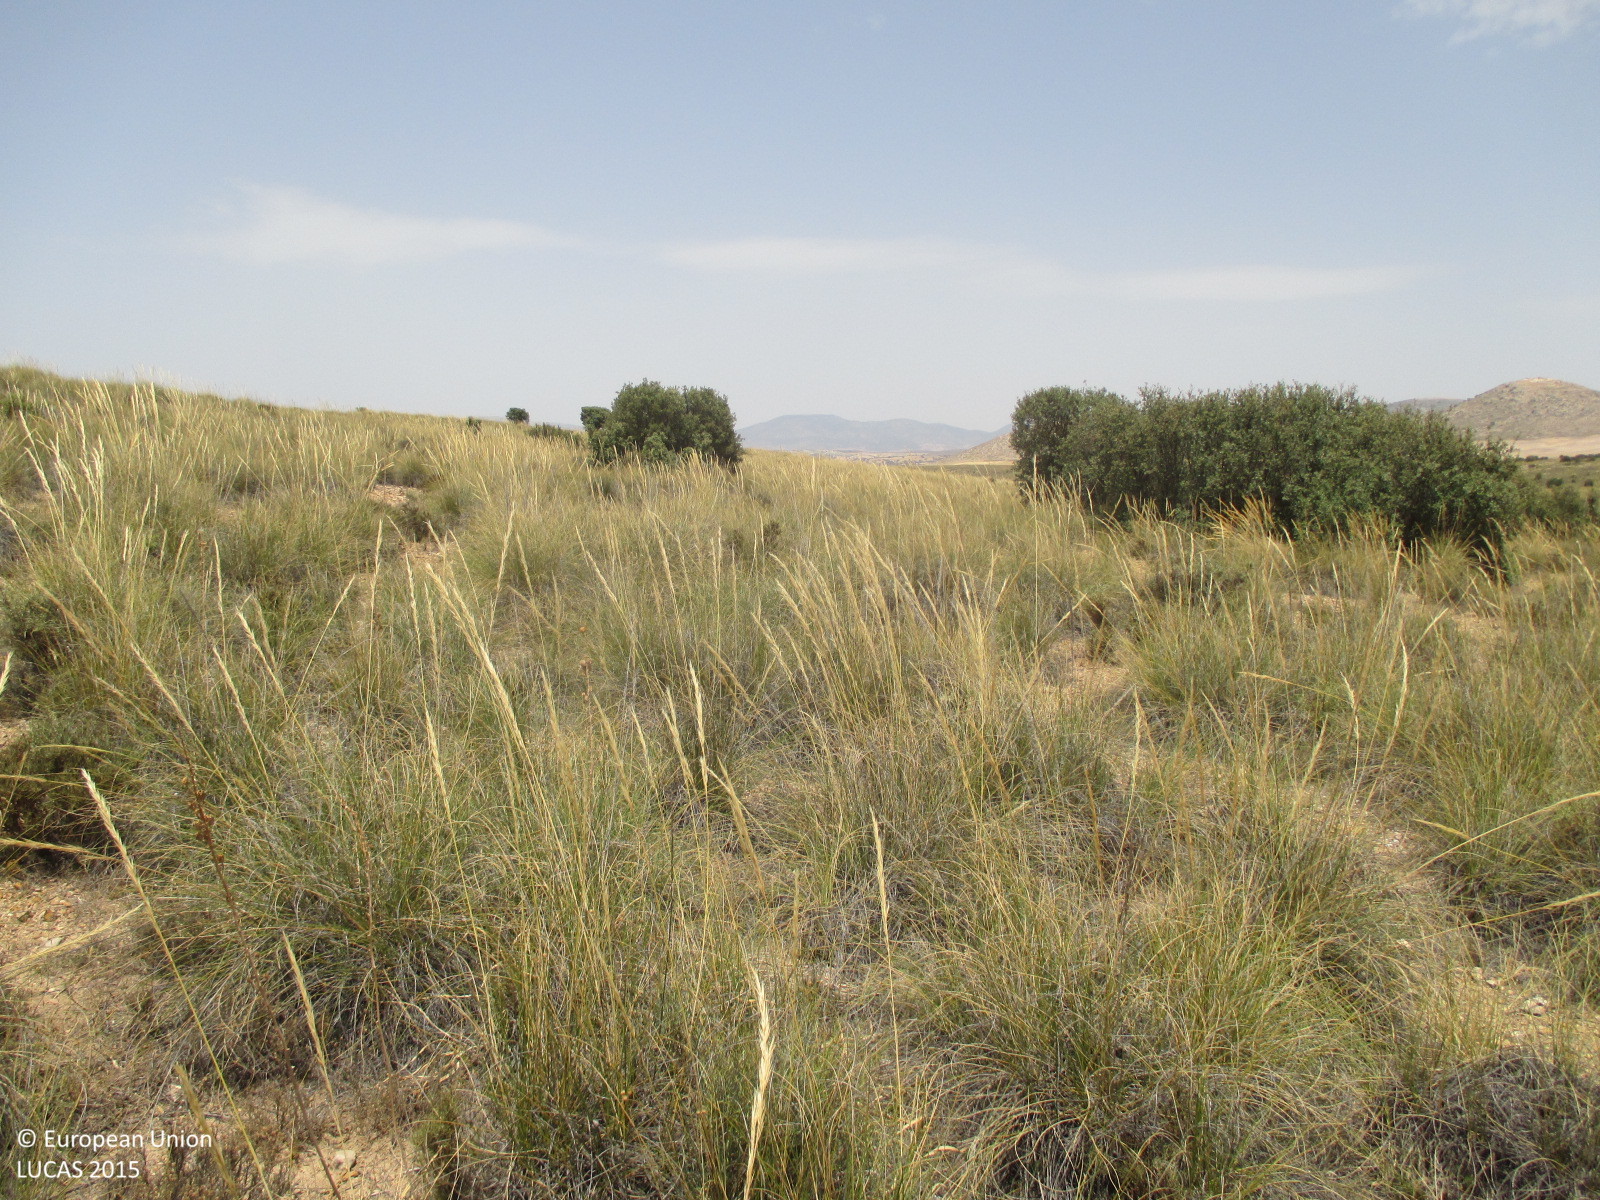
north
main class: Grassland
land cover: Grassland without tree/shrub cover
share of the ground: > 75 %
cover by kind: herbaceous plants 95 %, consolidated bare surface 5 %
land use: Semi-natural and natural areas not in use
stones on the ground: < 10 %
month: July
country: ES
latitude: 37.8619
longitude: -2.2990
